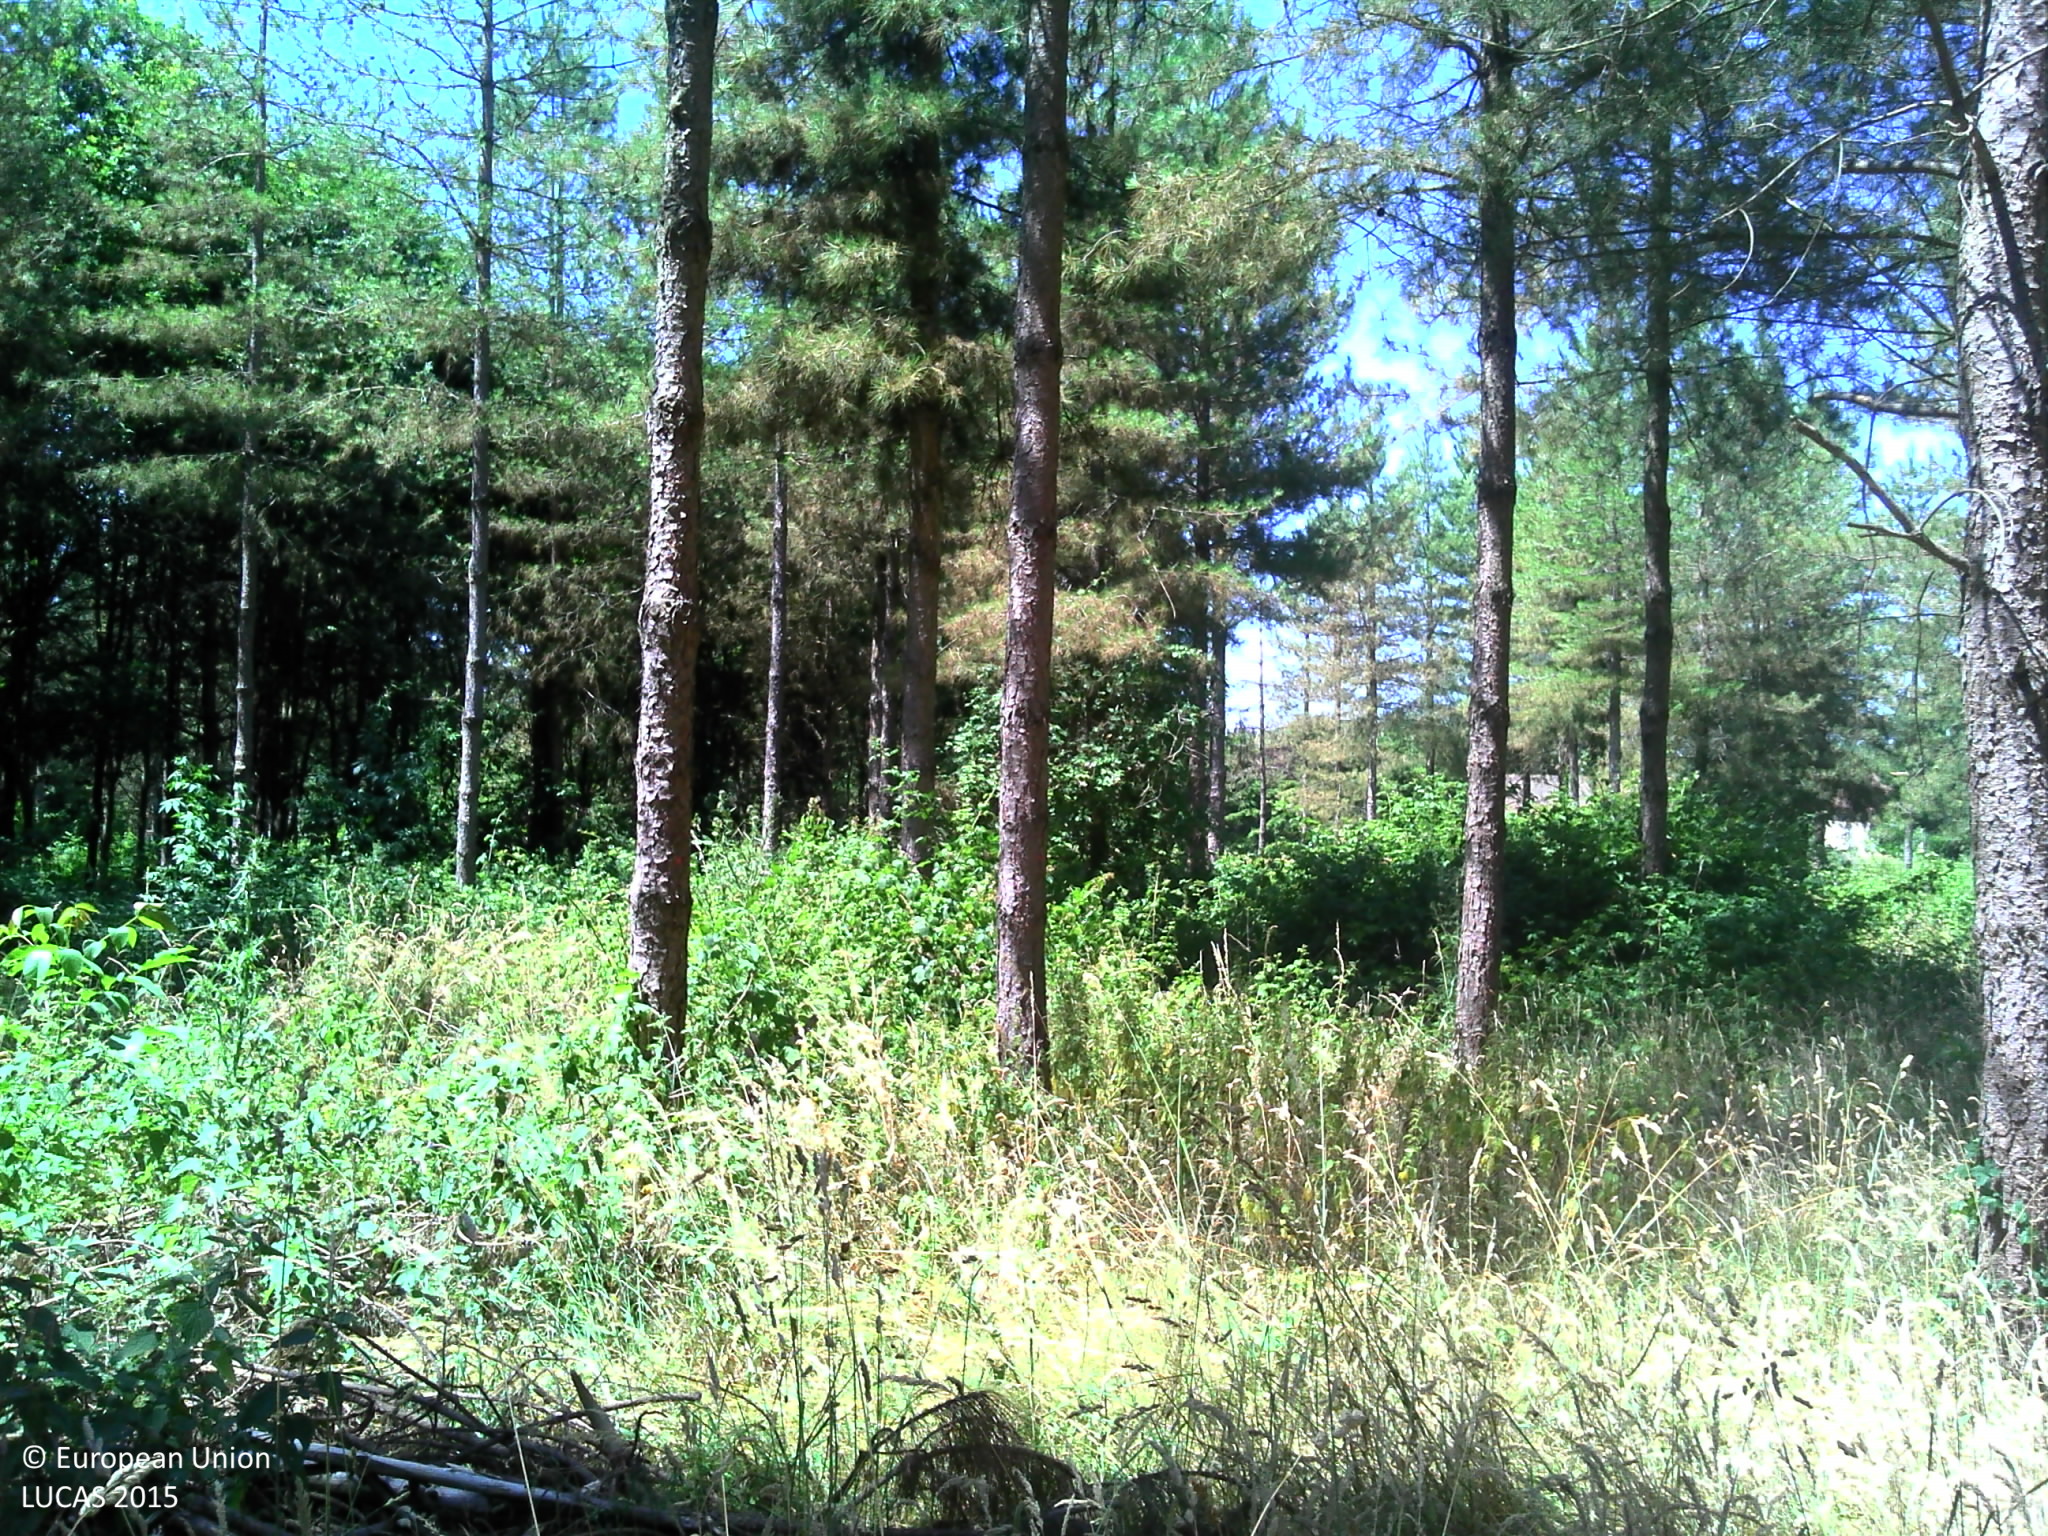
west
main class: Woodland
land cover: Spruce dominated coniferous woodland
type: exotic forest
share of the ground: > 75 %
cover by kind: coniferous forest trees 75 %, shrubs 15 %, herbaceous plants 10 %
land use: Forestry
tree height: > 5 m
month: June
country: FR
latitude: 47.9953
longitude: 0.3126
